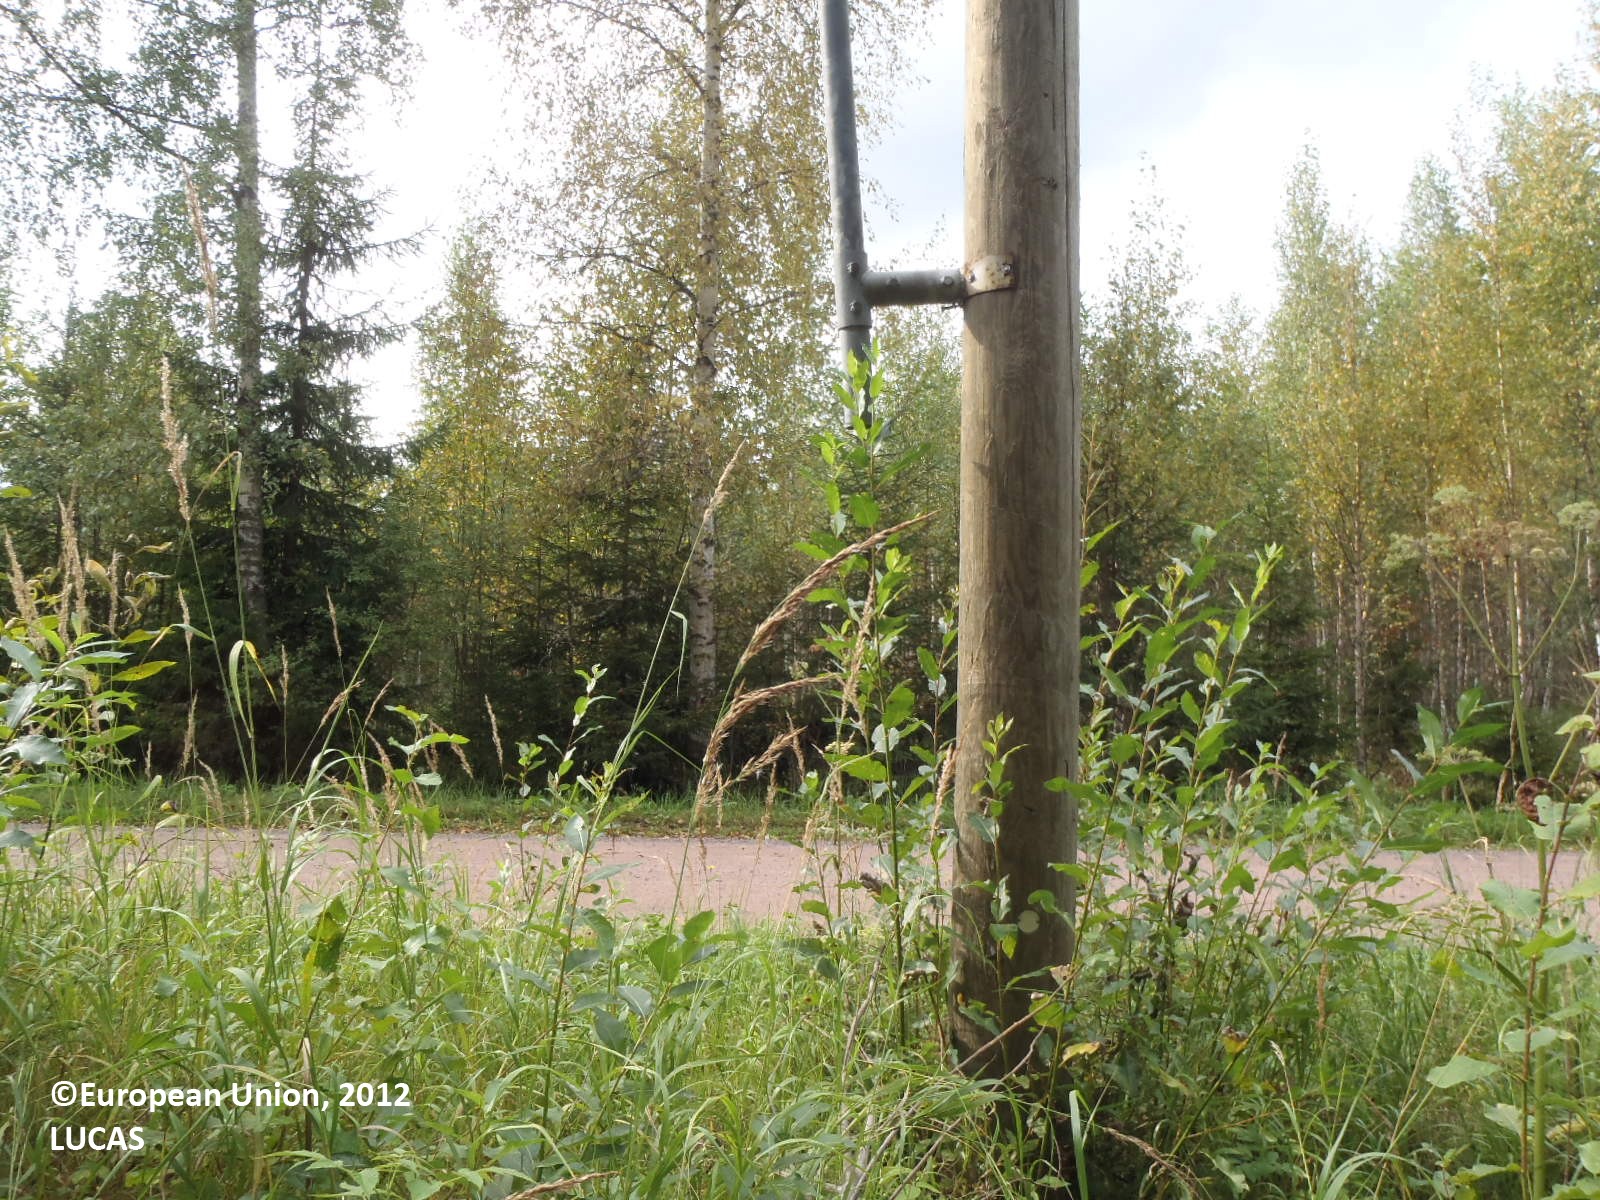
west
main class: Woodland
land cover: Broadleaved woodland
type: boreal forest
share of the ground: > 75 %
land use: Forestry
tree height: > 5 m
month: August
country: FI
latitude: 60.9736
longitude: 22.5011
